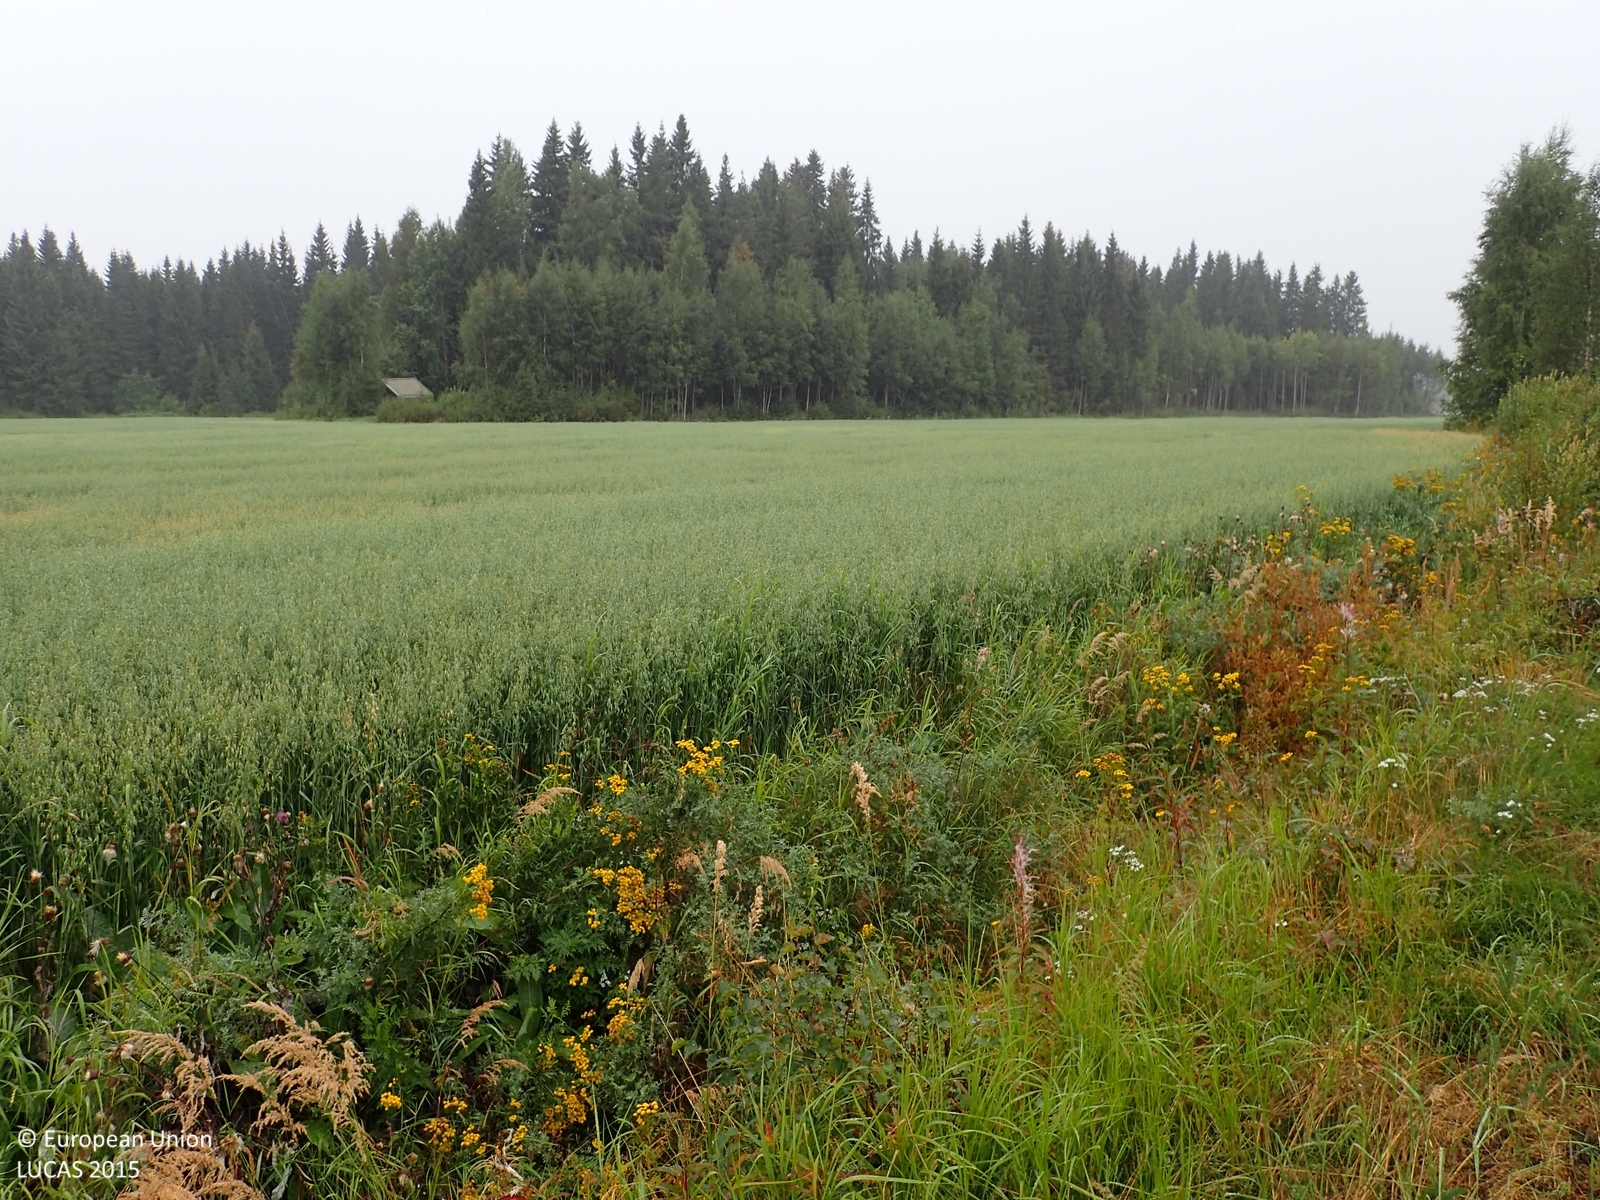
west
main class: Cropland
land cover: Oats
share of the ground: > 75 %
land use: Agriculture (excluding fallow land and kitchen gardens)
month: August
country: FI
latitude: 62.6671
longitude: 22.8065
